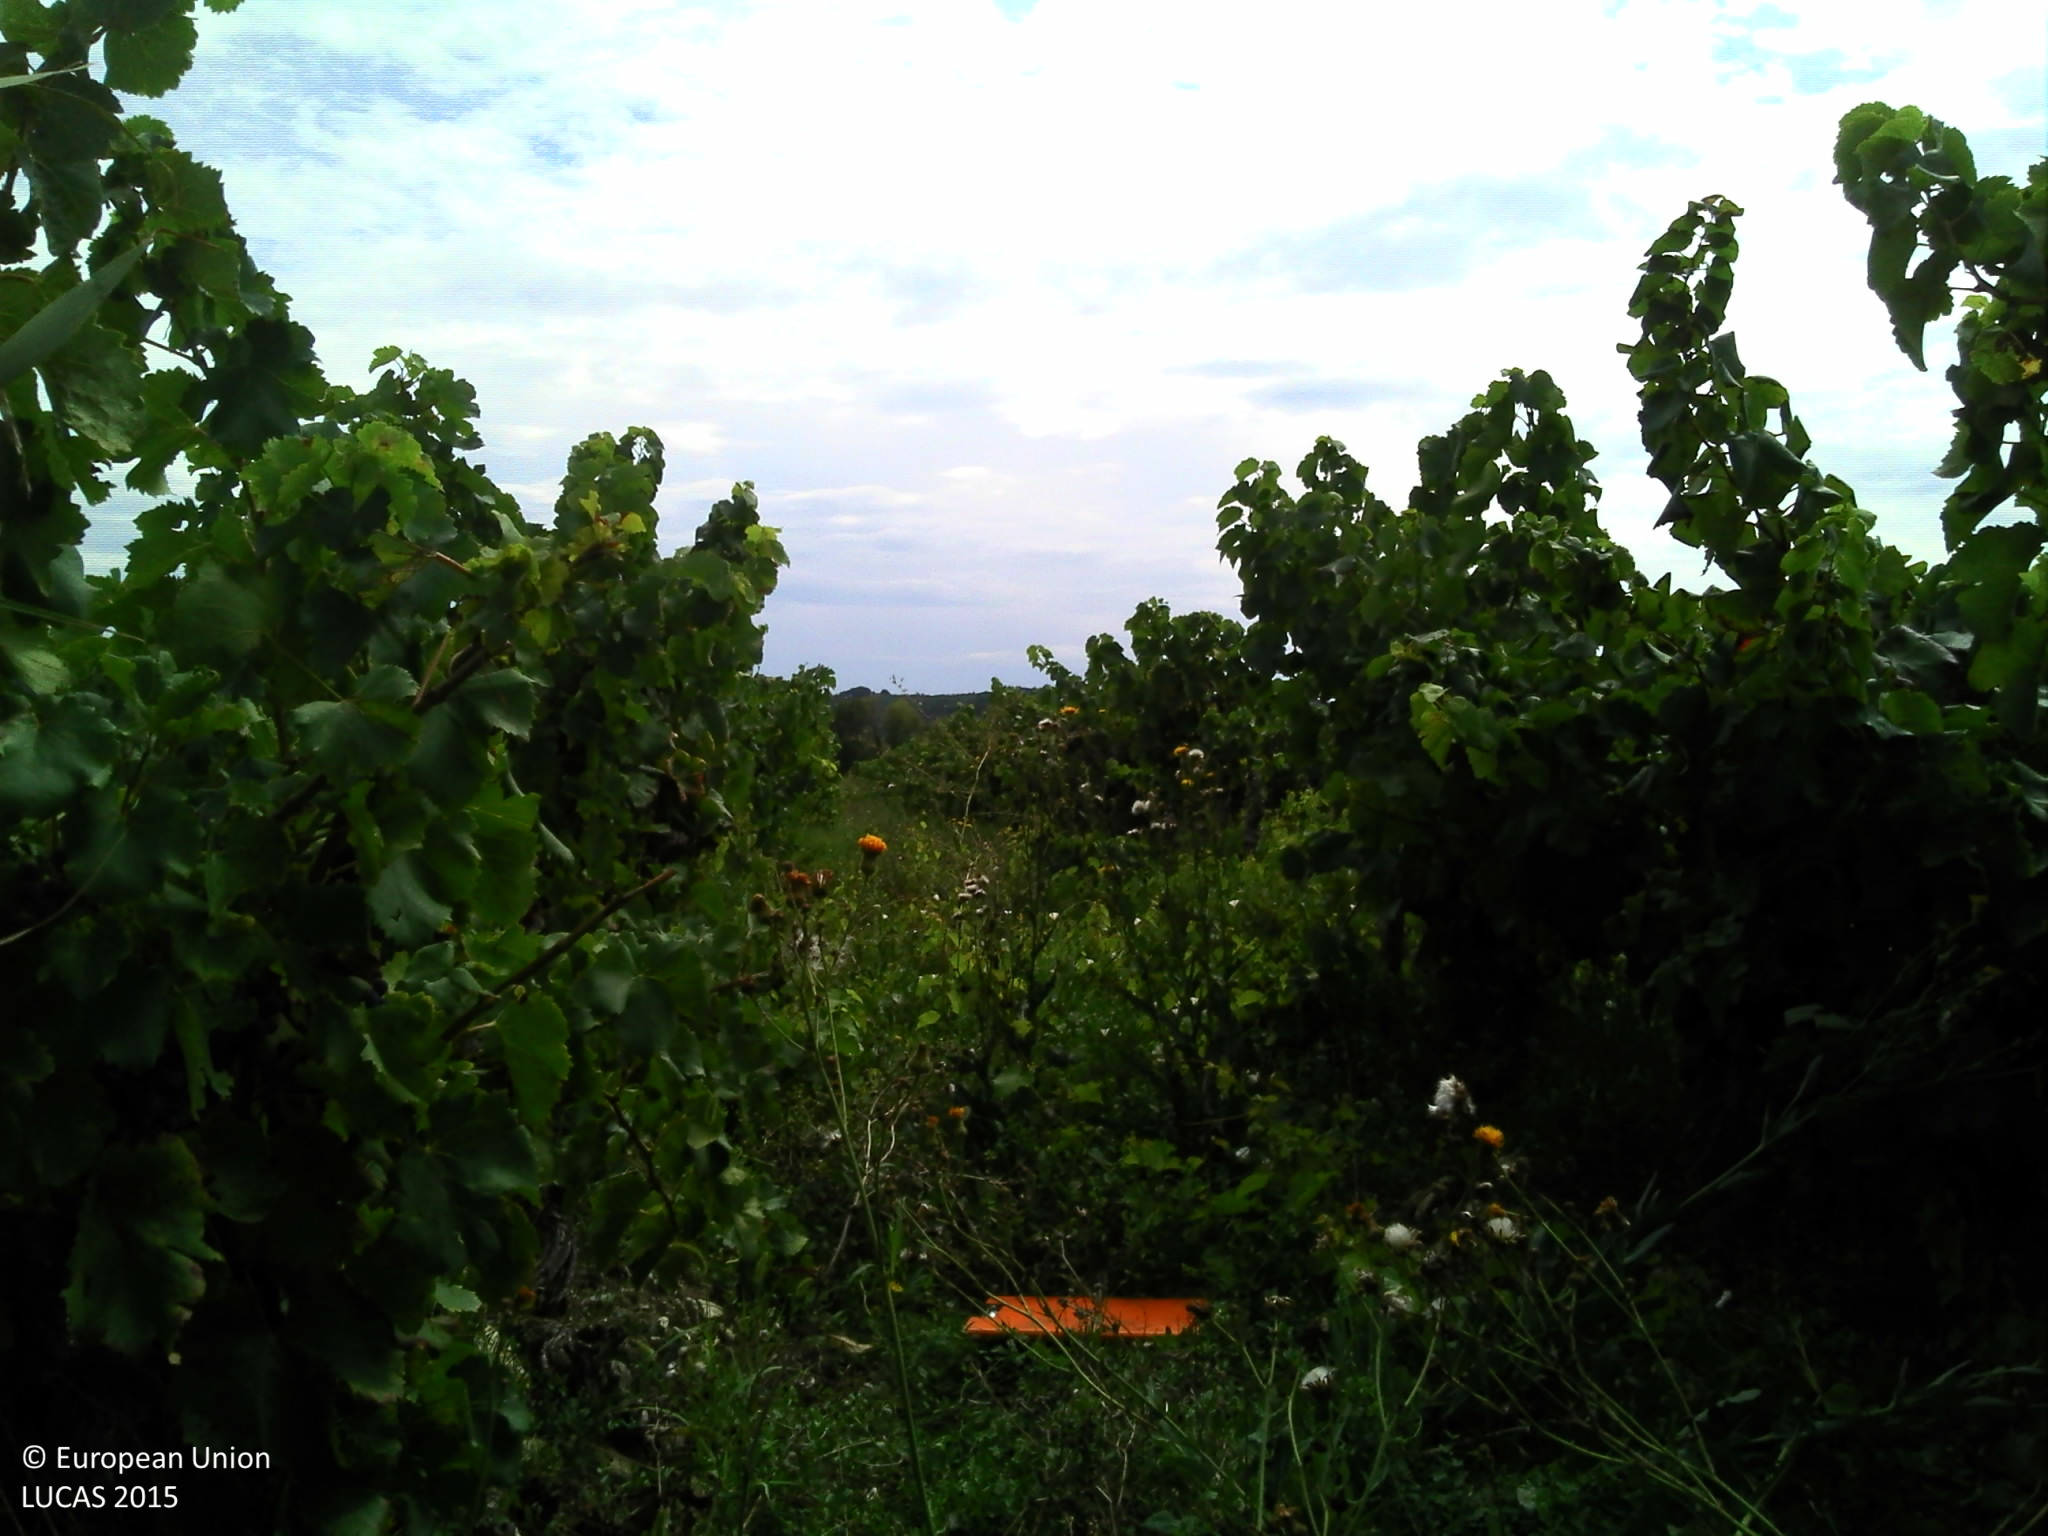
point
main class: Cropland
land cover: Vineyards
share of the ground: 10 - 25 %
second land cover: Grassland without tree/shrub cover
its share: > 75 %
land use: Agriculture (excluding fallow land and kitchen gardens)
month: September
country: FR
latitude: 44.3038
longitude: 5.0311
